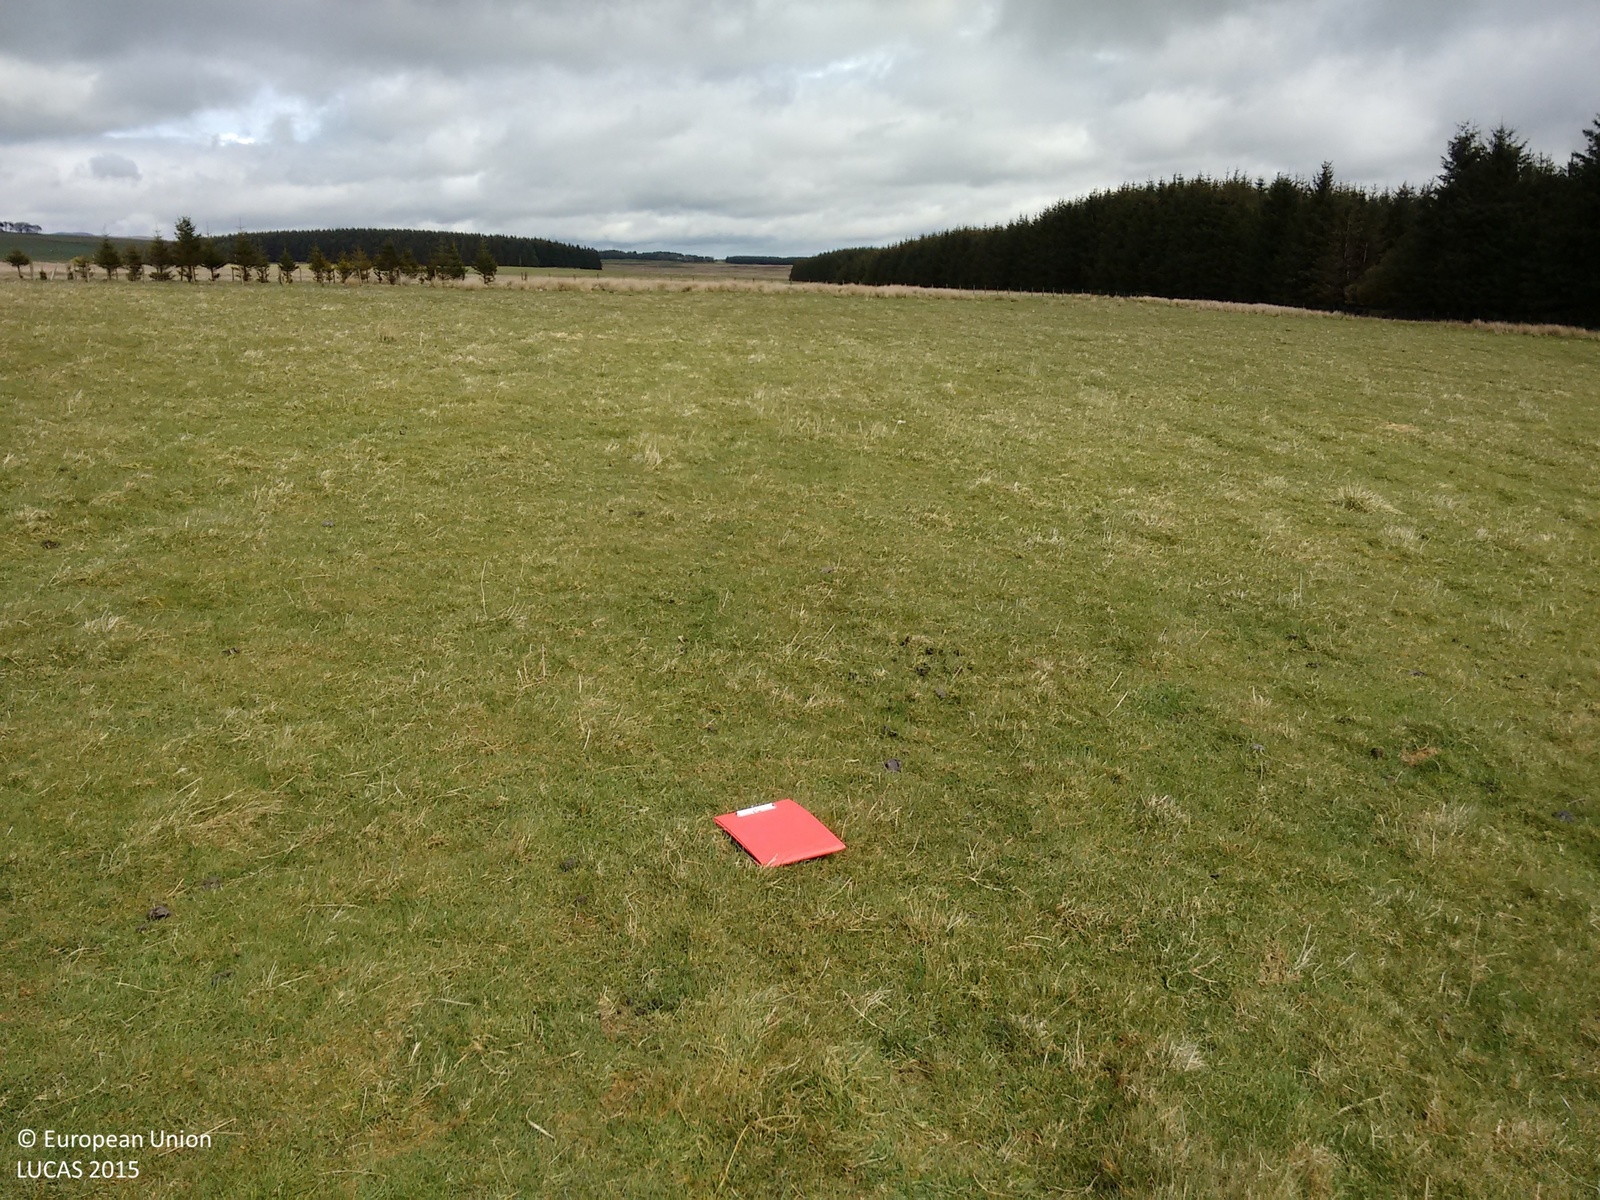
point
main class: Grassland
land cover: Grassland without tree/shrub cover
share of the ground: > 75 %
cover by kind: herbaceous plants 100 %
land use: Agriculture (excluding fallow land and kitchen gardens)
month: May
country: GB
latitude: 55.7763
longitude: -3.1930
